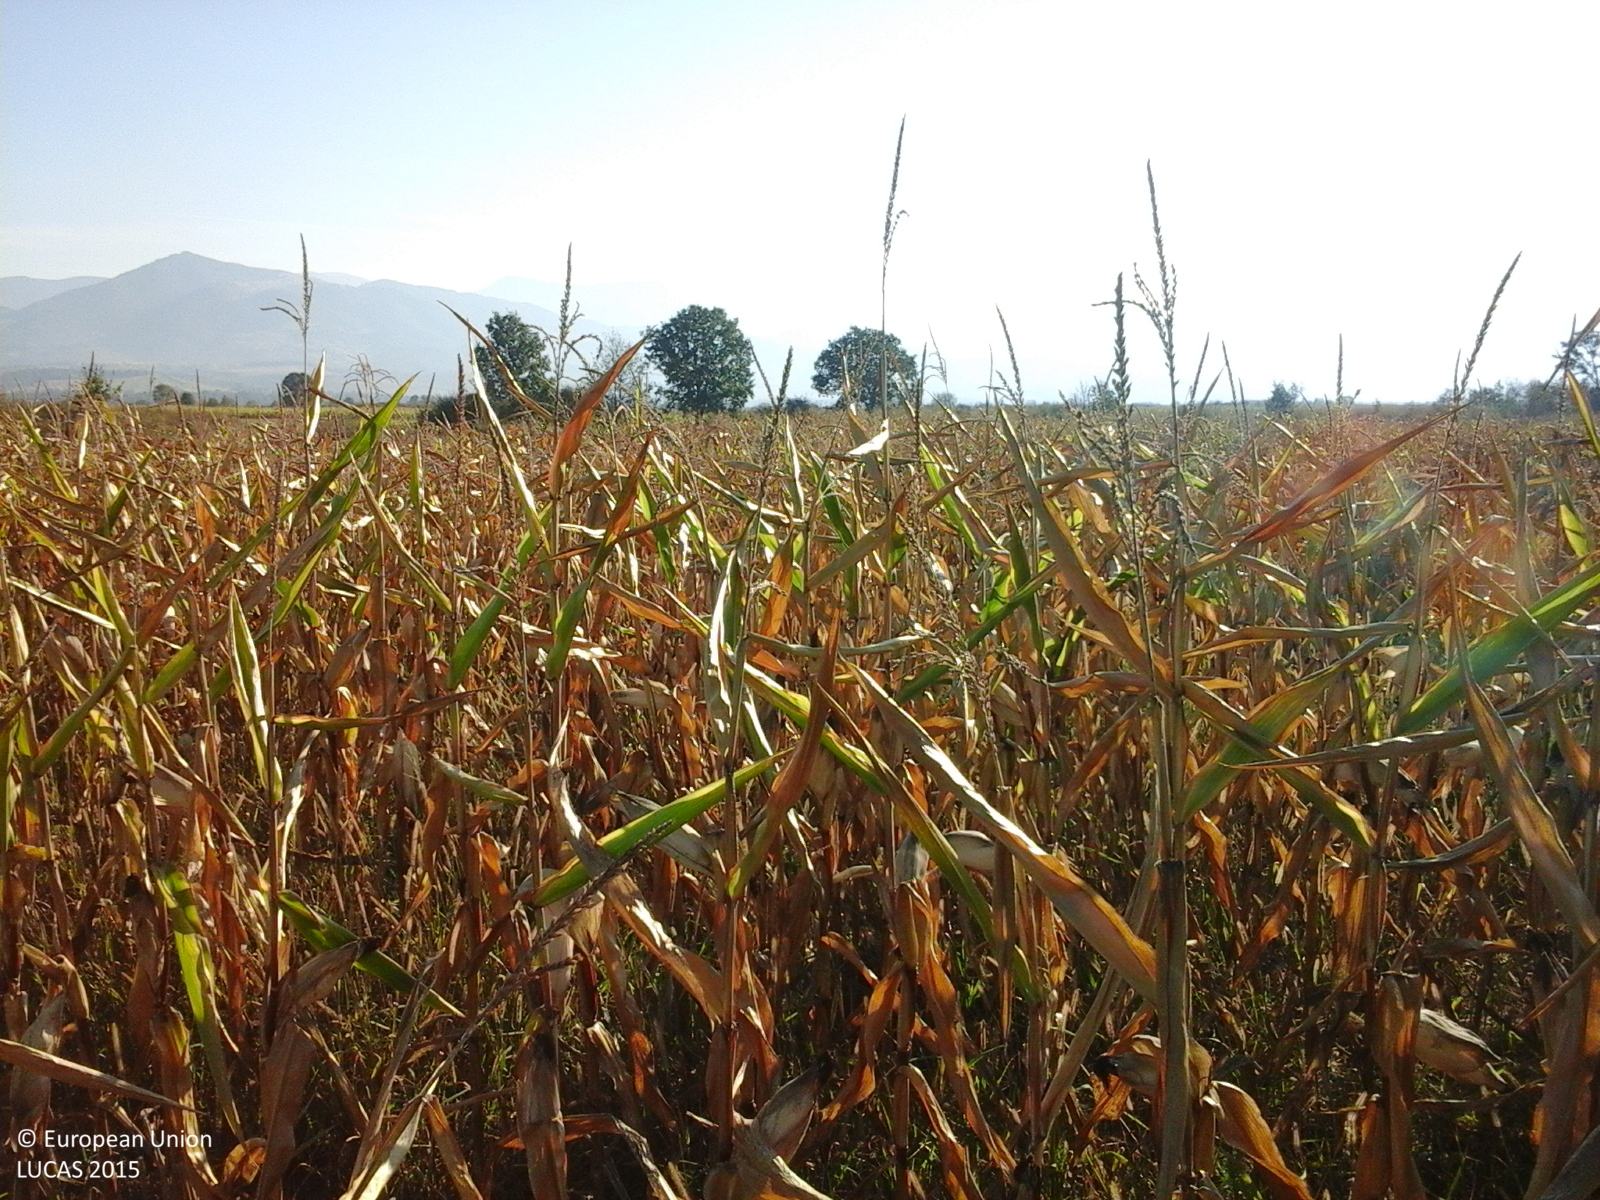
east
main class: Cropland
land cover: Maize
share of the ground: > 75 %
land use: Agriculture (excluding fallow land and kitchen gardens)
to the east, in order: Maize; Common wheat; Maize; Common wheat; Grassland without tree/shrub cover; Tracks; Shruby margins; Ditches and canals; Shruby margins; Maize; Common wheat; Maize
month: September
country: RO
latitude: 46.6022
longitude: 22.4666
